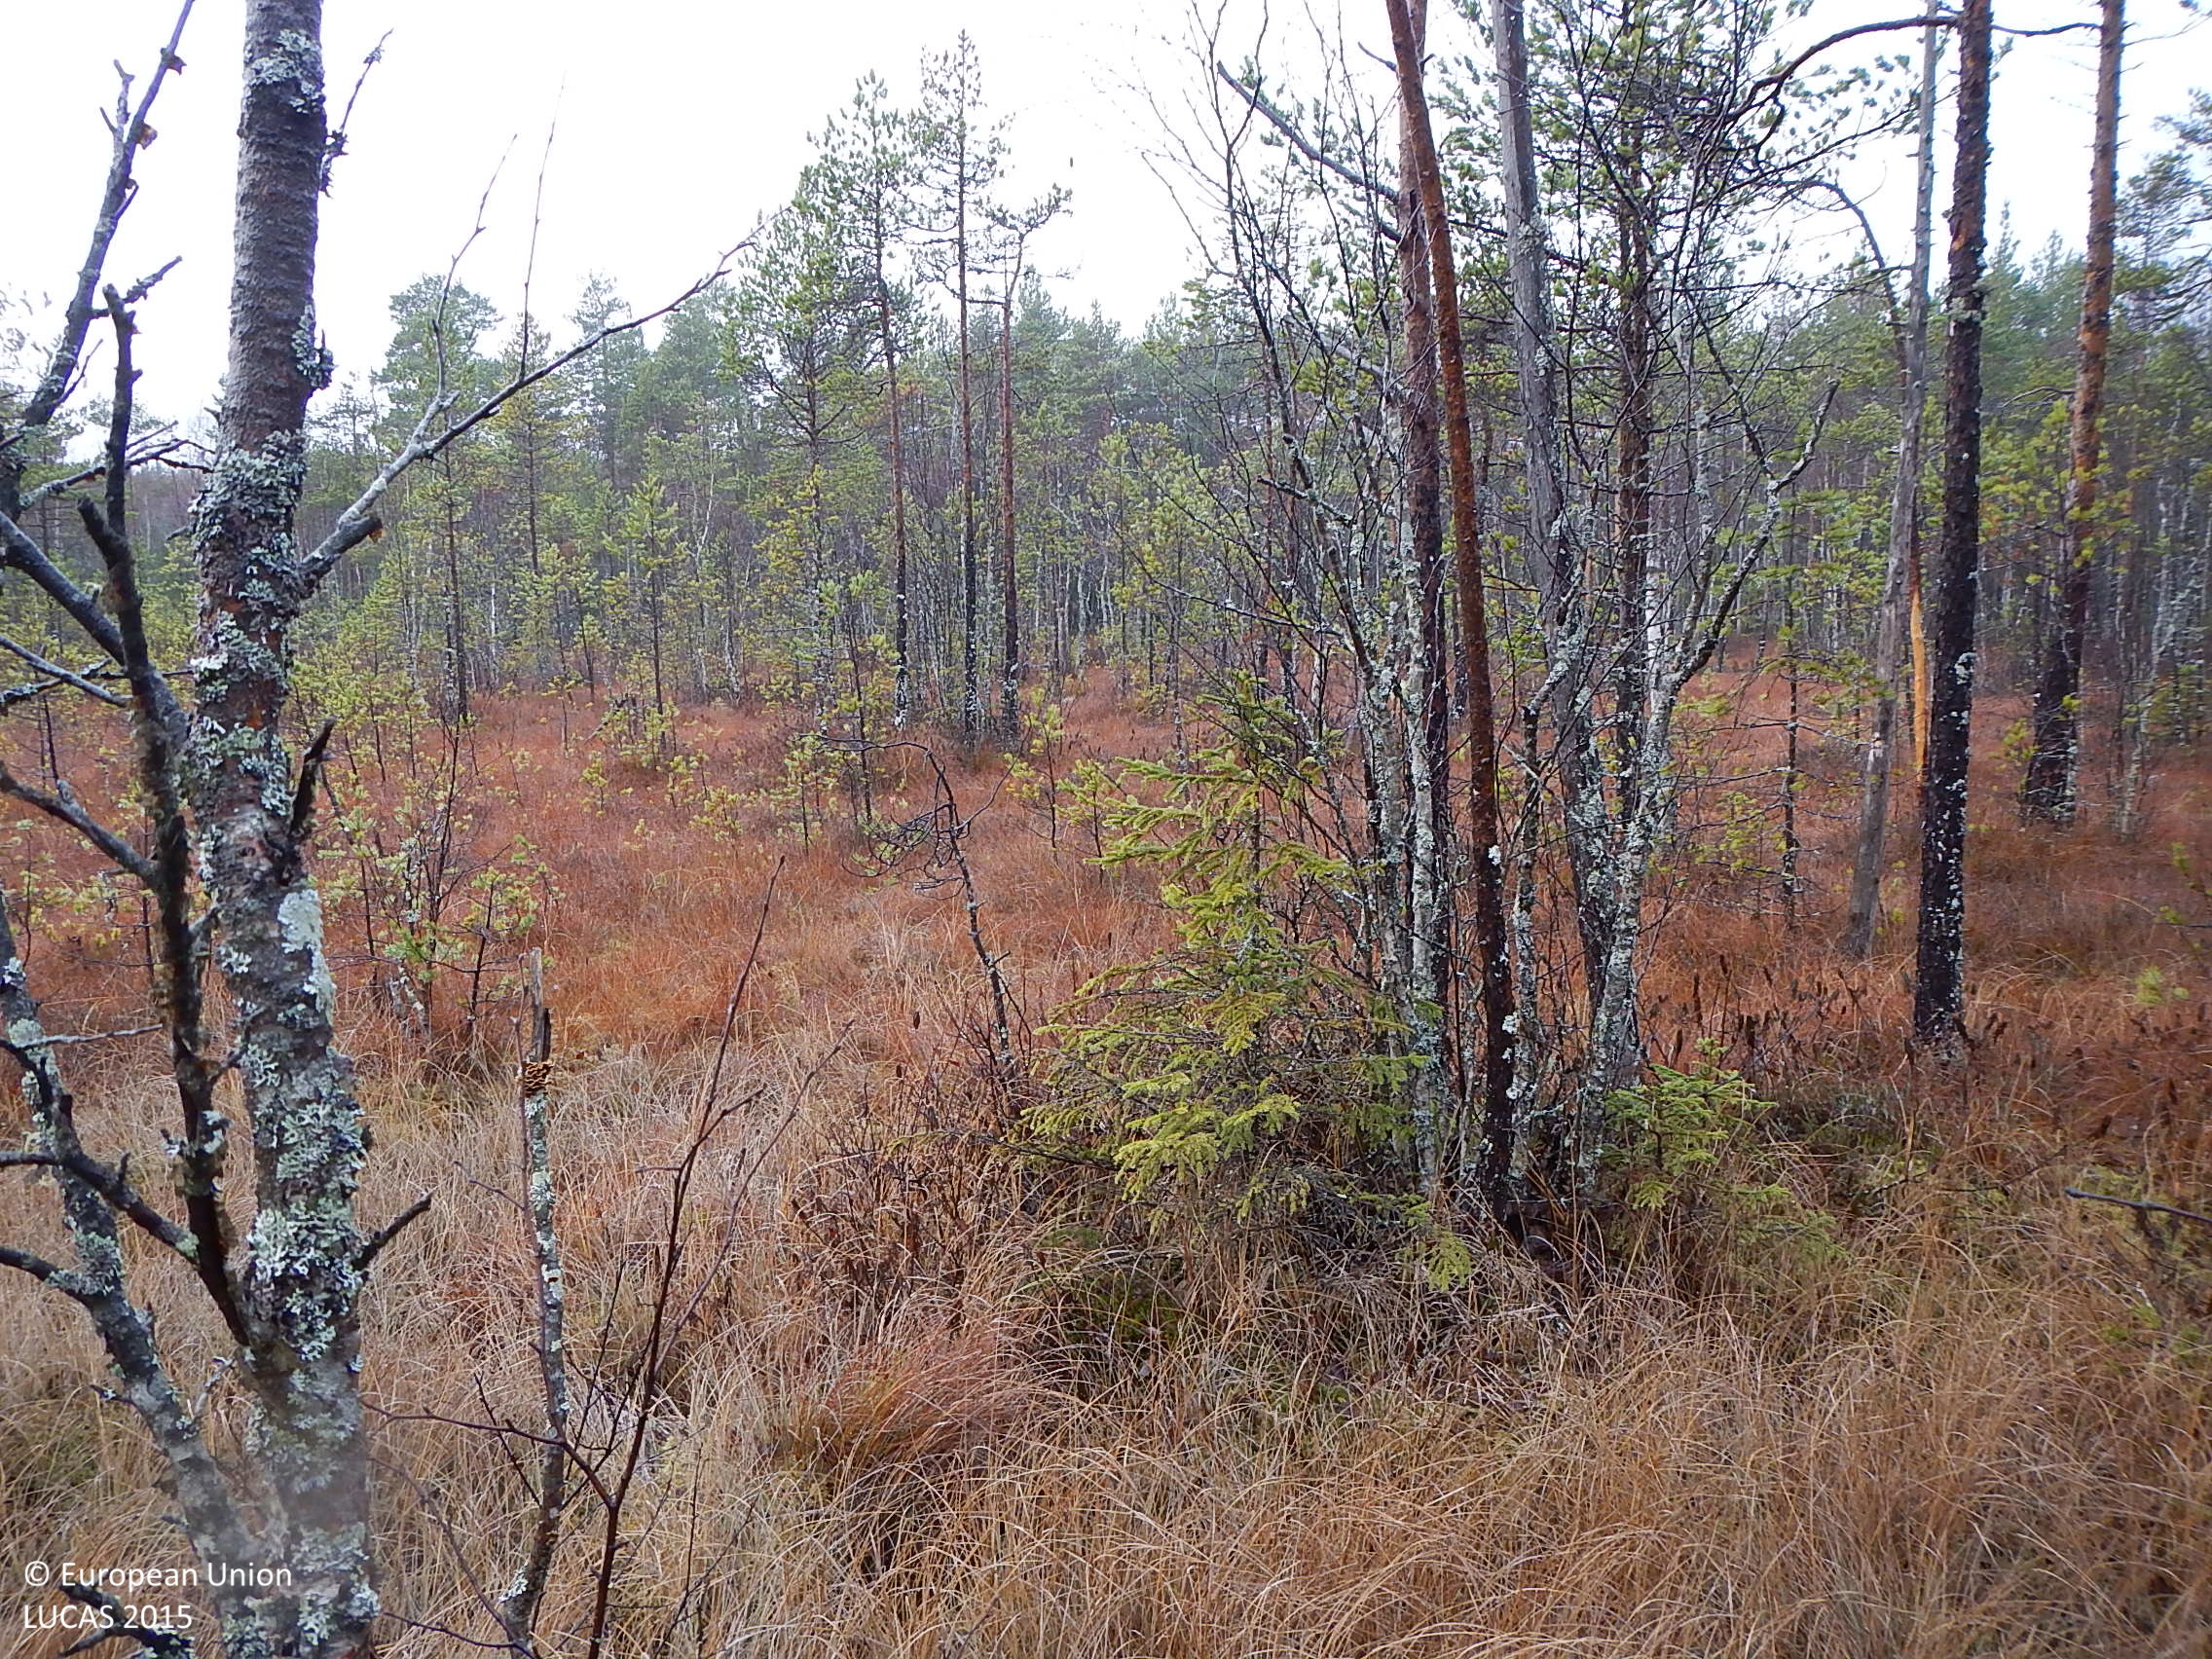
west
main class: Woodland
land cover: Pine dominated mixed woodland
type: mire and swamp forests
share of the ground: 50 - 75 %
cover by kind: coniferous forest trees 30 %, herbaceous plants 30 %, broadleaved forest trees 20 %, lichens and mosses 20 %
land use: Forestry
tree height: > 5 m
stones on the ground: < 10 %
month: November
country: SE
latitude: 61.4350
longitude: 17.0155
